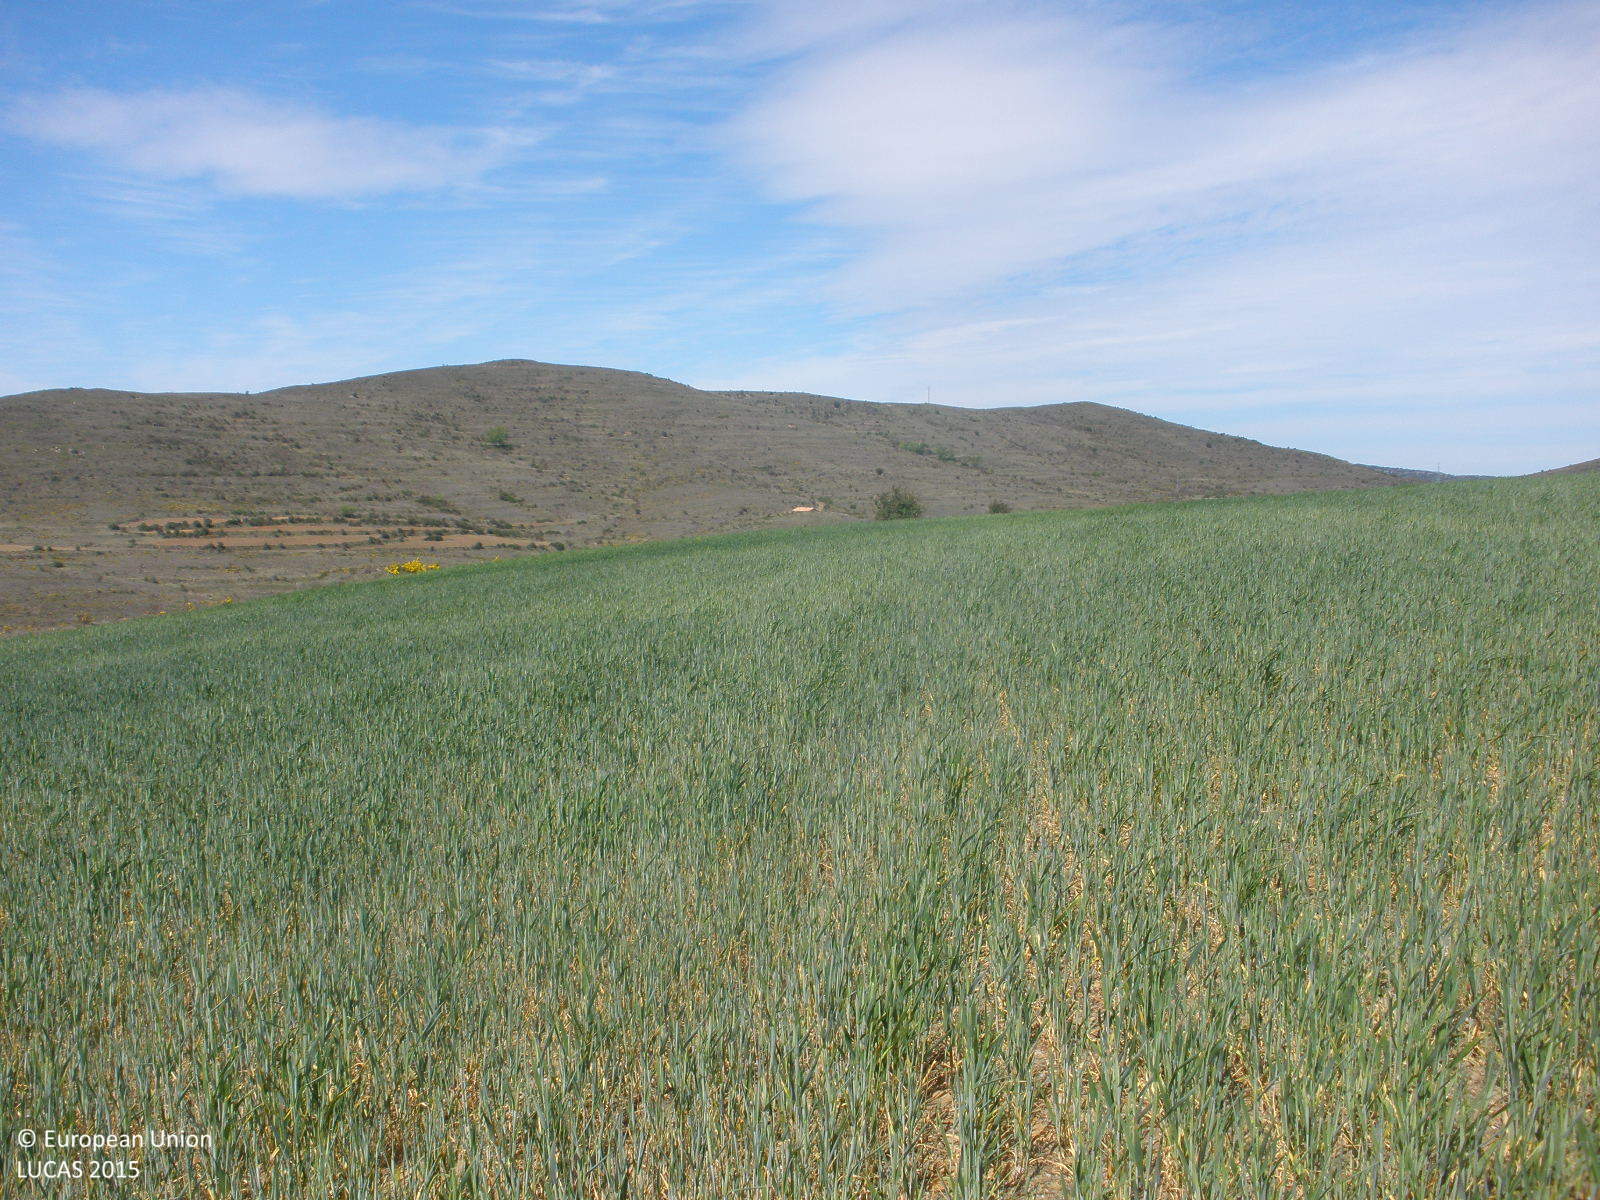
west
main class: Cropland
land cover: Rye
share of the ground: > 75 %
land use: Agriculture (excluding fallow land and kitchen gardens)
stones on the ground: > 50 %
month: May
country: ES
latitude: 40.9033
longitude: -0.8529
